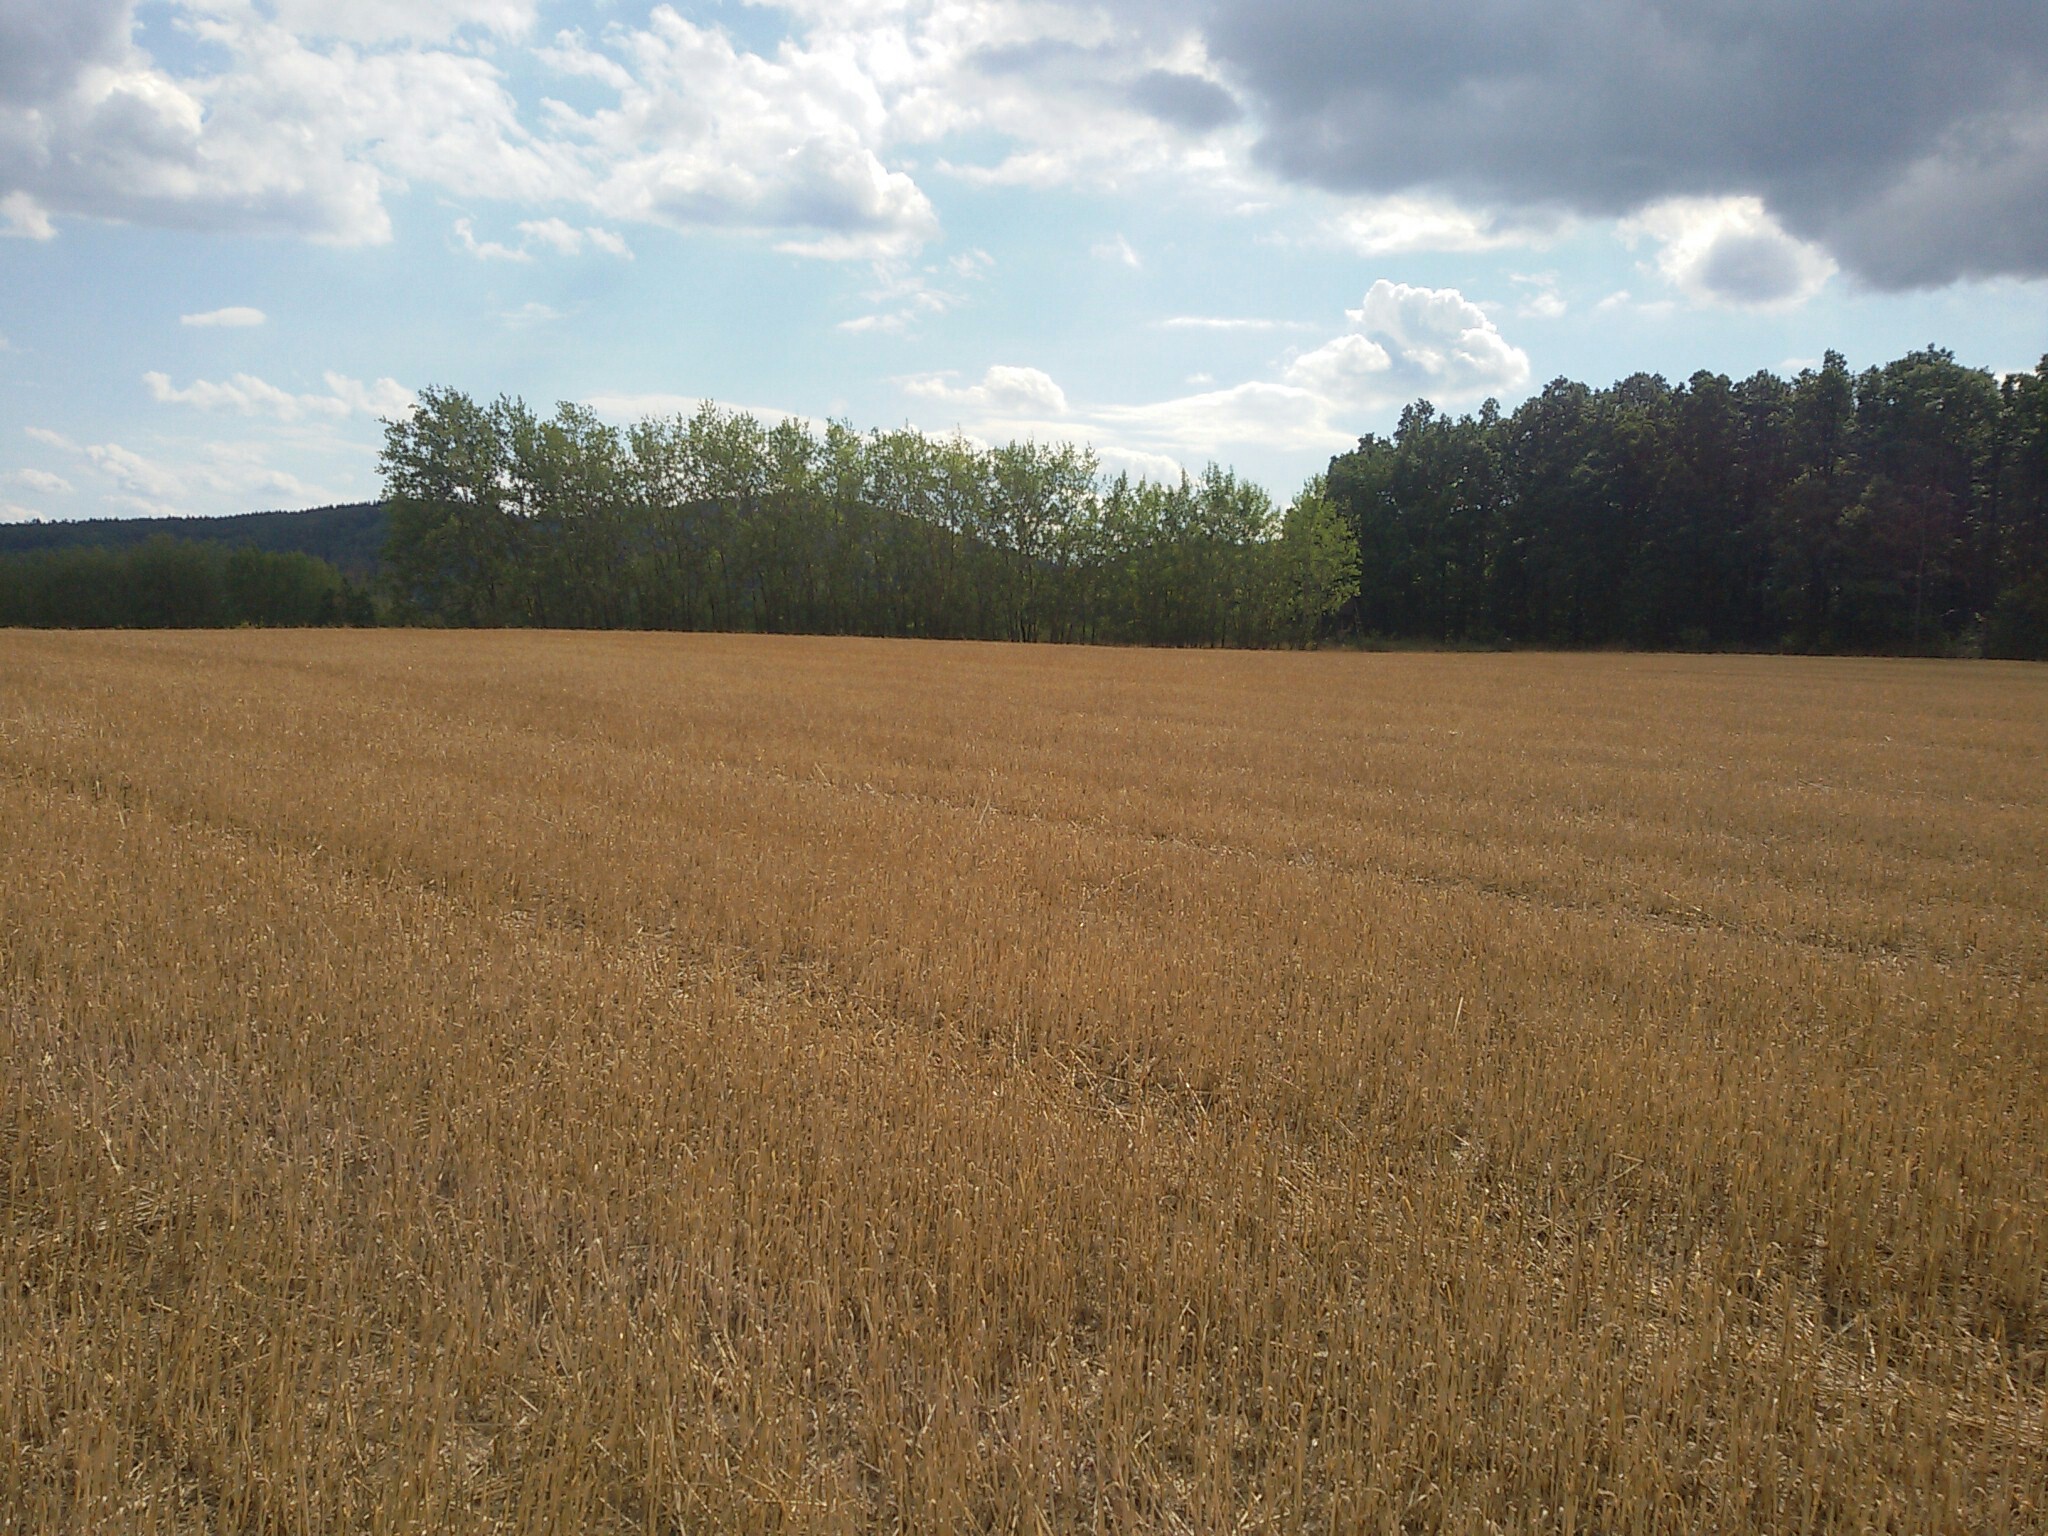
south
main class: Cropland
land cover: Common wheat
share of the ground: > 75 %
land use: Agriculture (excluding fallow land and kitchen gardens)
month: September
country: PL
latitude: 50.5458
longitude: 16.7119
